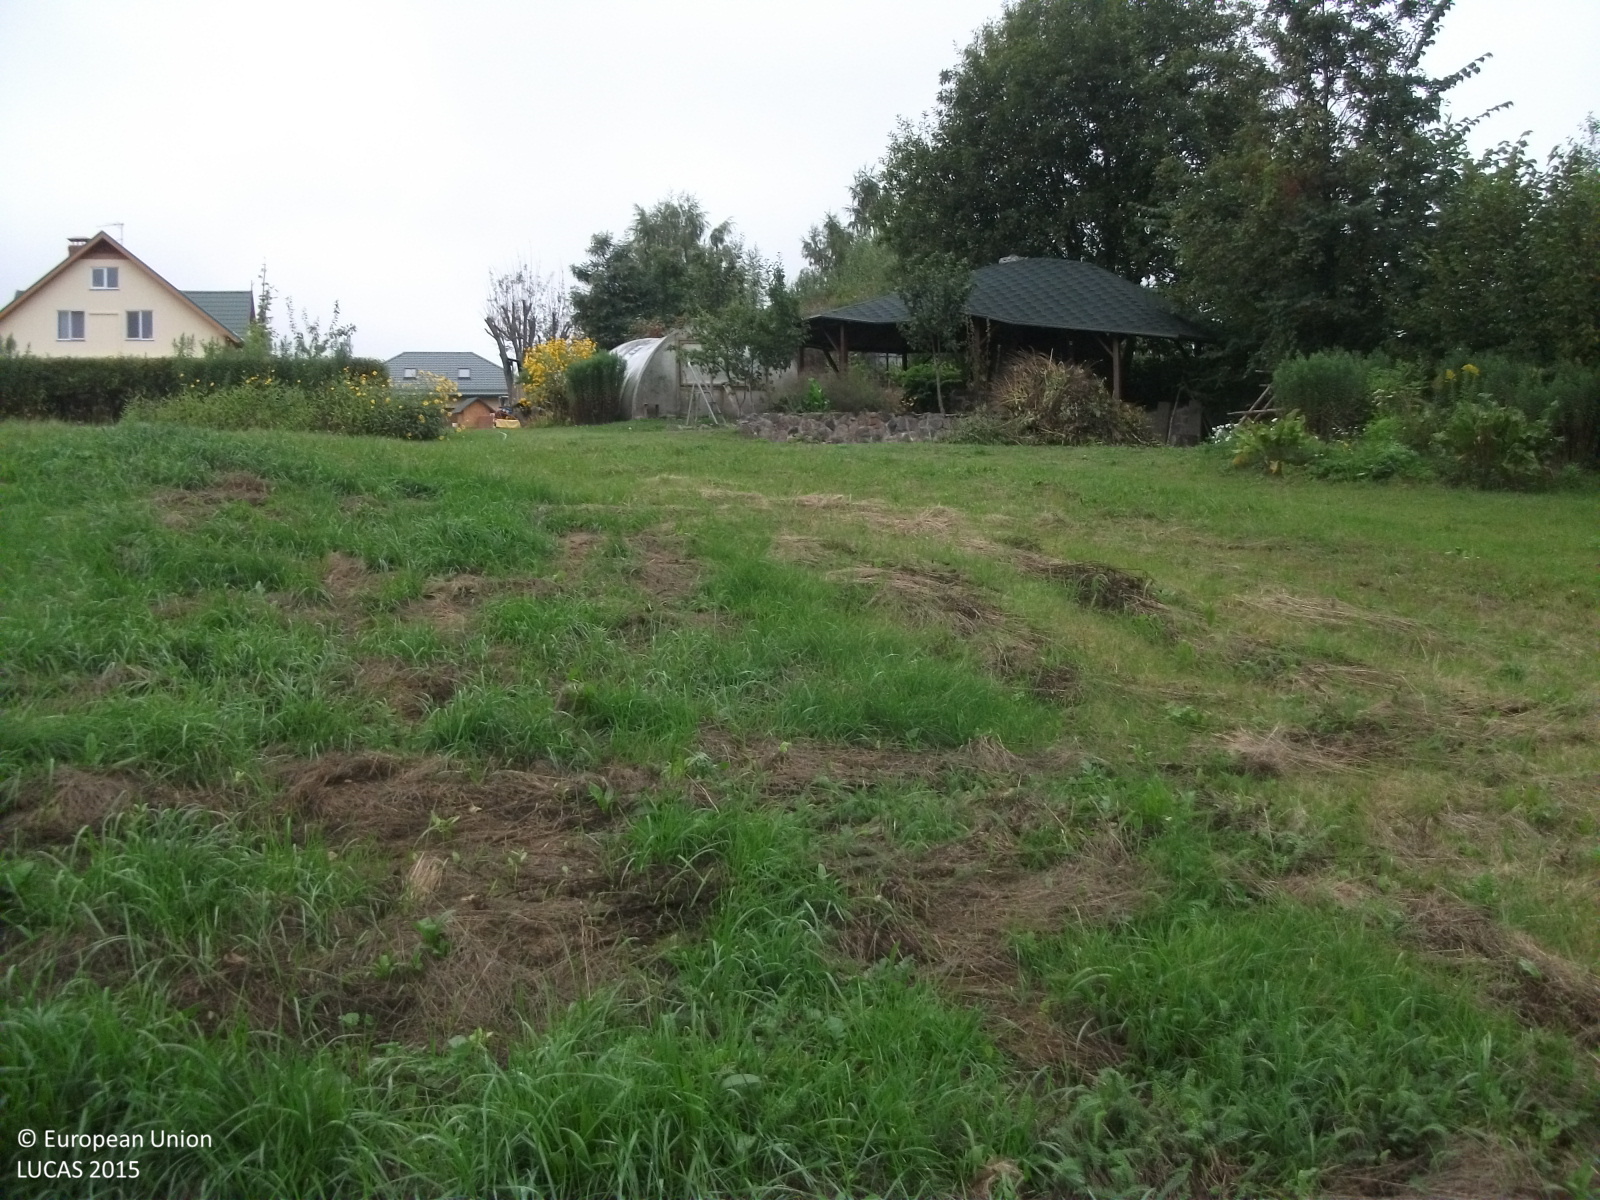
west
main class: Grassland
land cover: Grassland without tree/shrub cover
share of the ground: > 75 %
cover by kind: herbaceous plants 90 %, unconsolidated bare surface 5 %
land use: Residential
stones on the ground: < 10 %
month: September
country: LV
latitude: 57.4969
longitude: 24.6956
